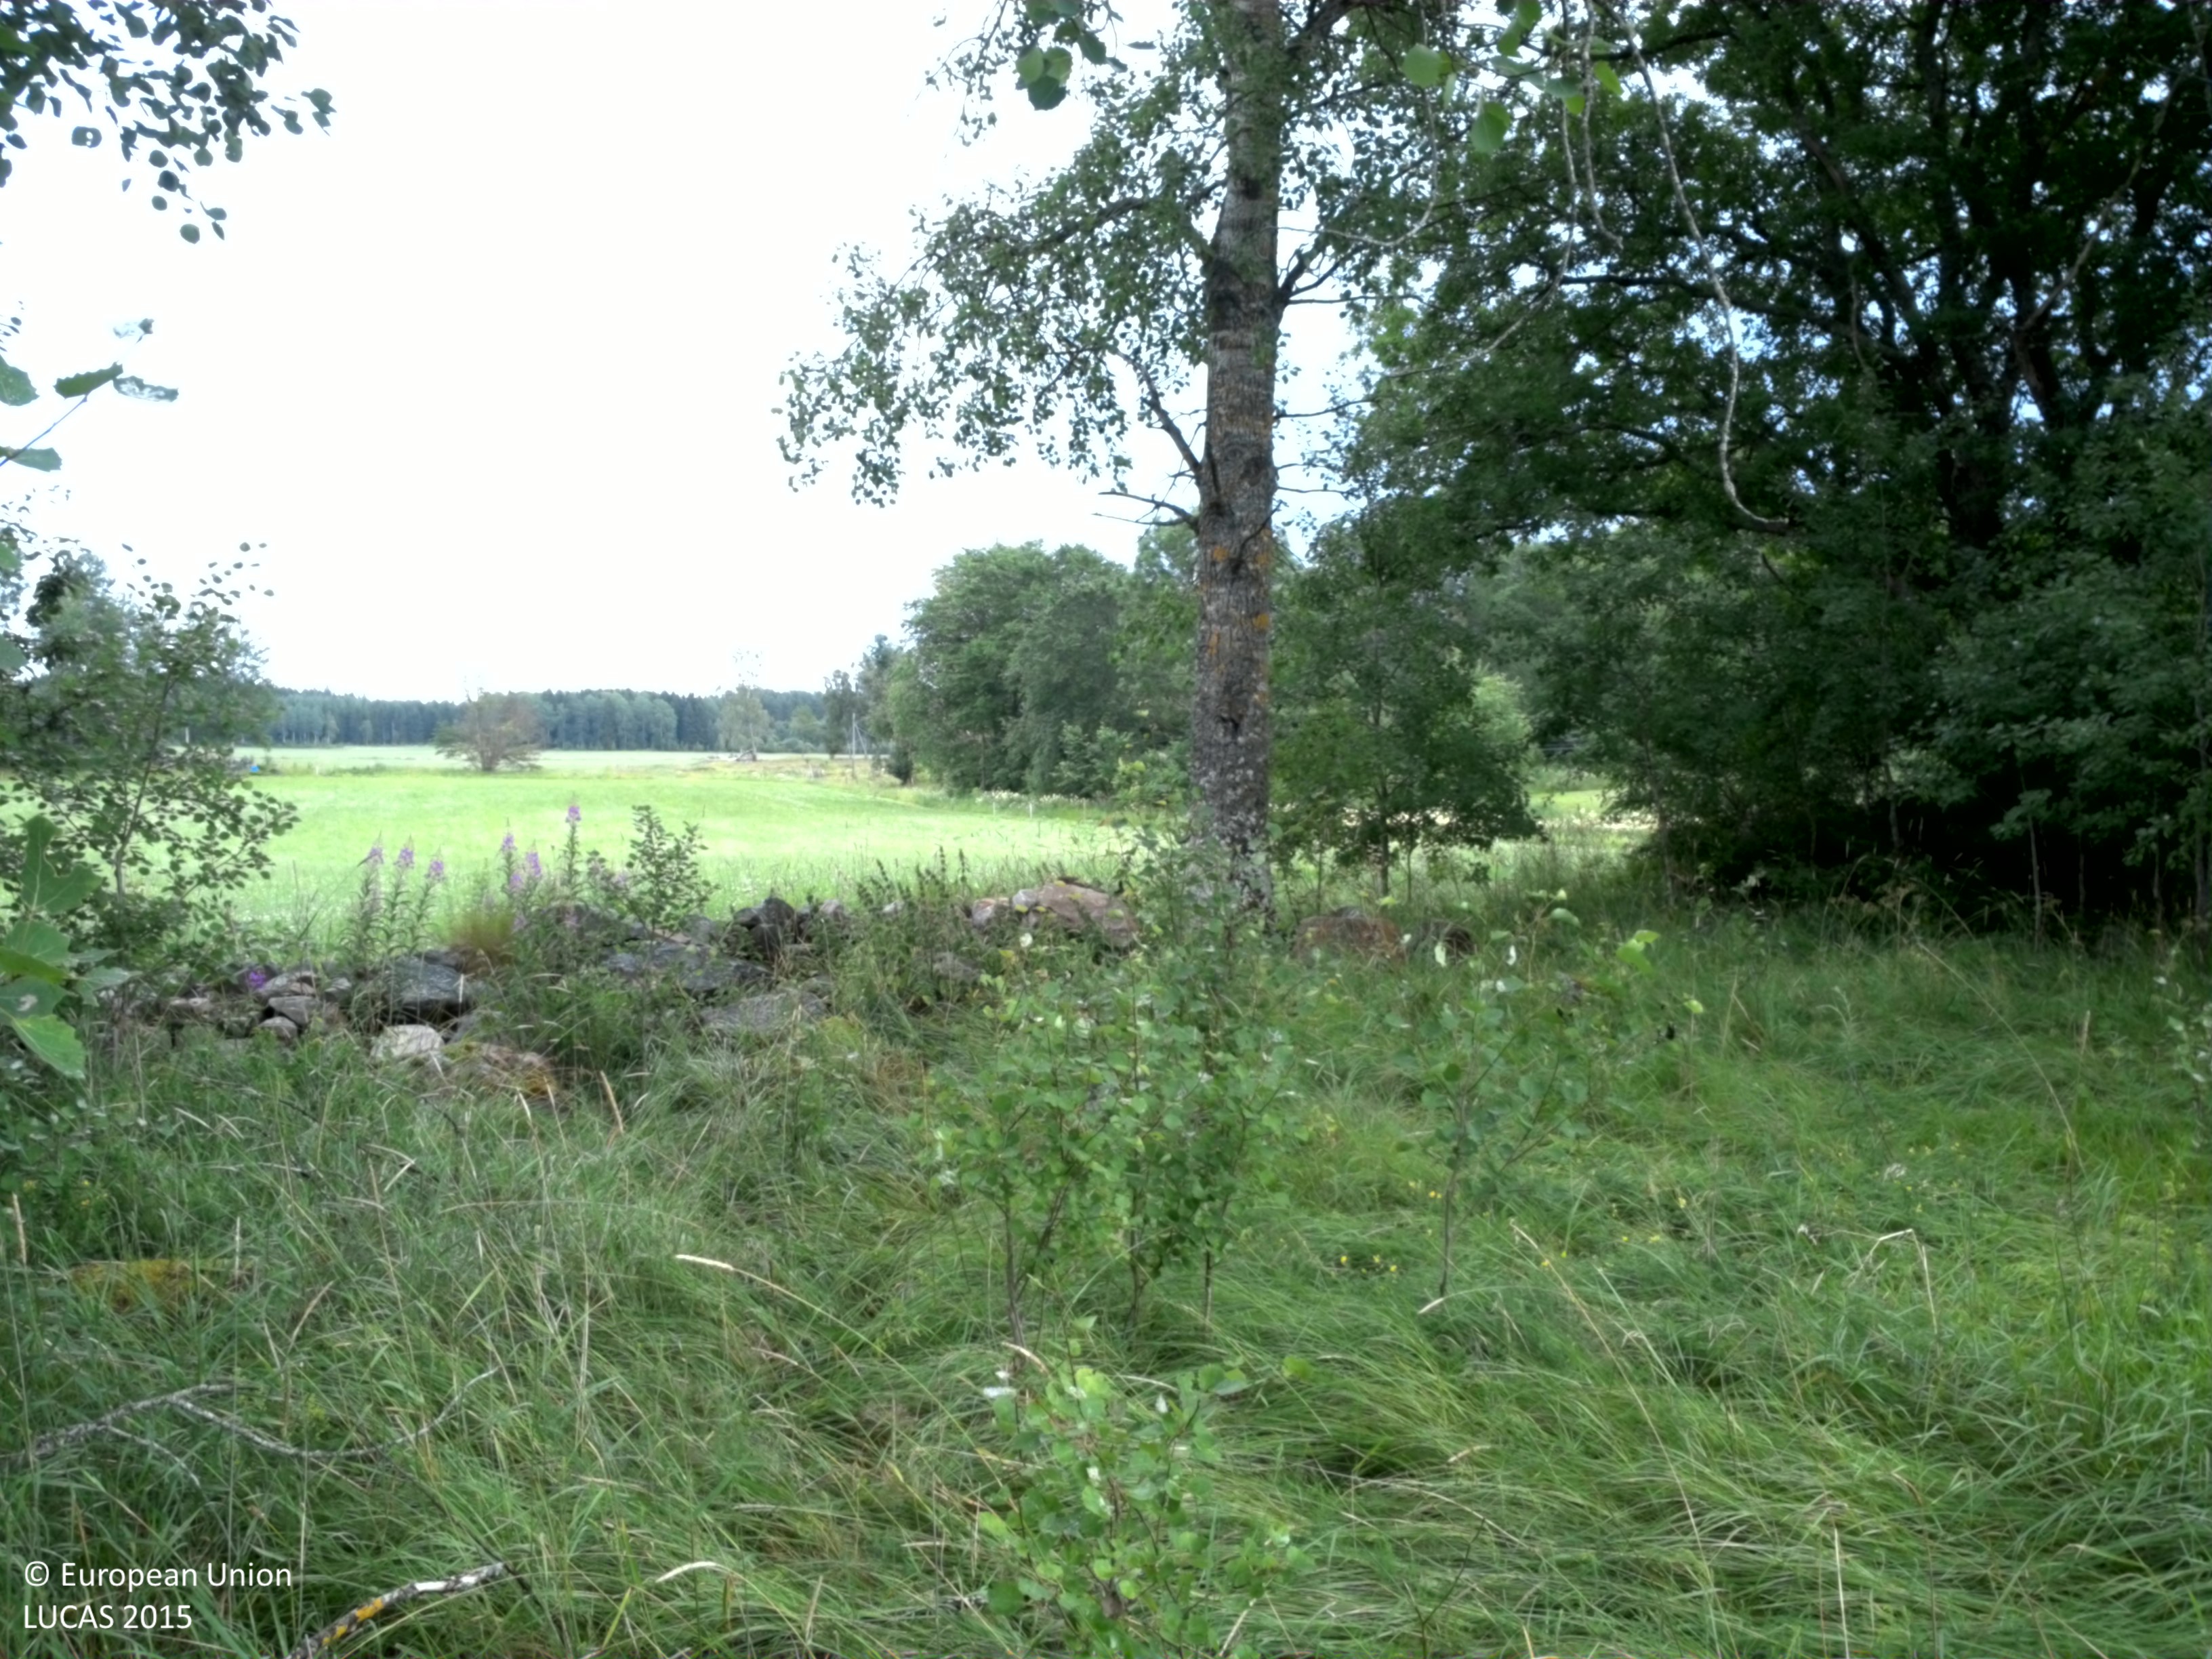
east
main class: Woodland
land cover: Broadleaved woodland
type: hemiboreal forest and nemoral coniferous forest and mixed broadleaved-coniferous forest
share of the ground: 25 - 50 %
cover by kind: broadleaved forest trees 50 %, herbaceous plants 50 %
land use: Semi-natural and natural areas not in use
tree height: > 5 m
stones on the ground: < 10 %
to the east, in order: Broadleaved woodland; Electric lines; Dry stone walls; Fences; Other leguminous and mixtures for fodder; Artificial constructions in urban areas; Grassland without tree/shrub cover; Fences; Paved roads, cycling and walking lanes; Ditches and canals; Broadleaved woodland; Paved roads, cycling and walking lanes
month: July
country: SE
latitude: 59.9734
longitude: 18.5799
